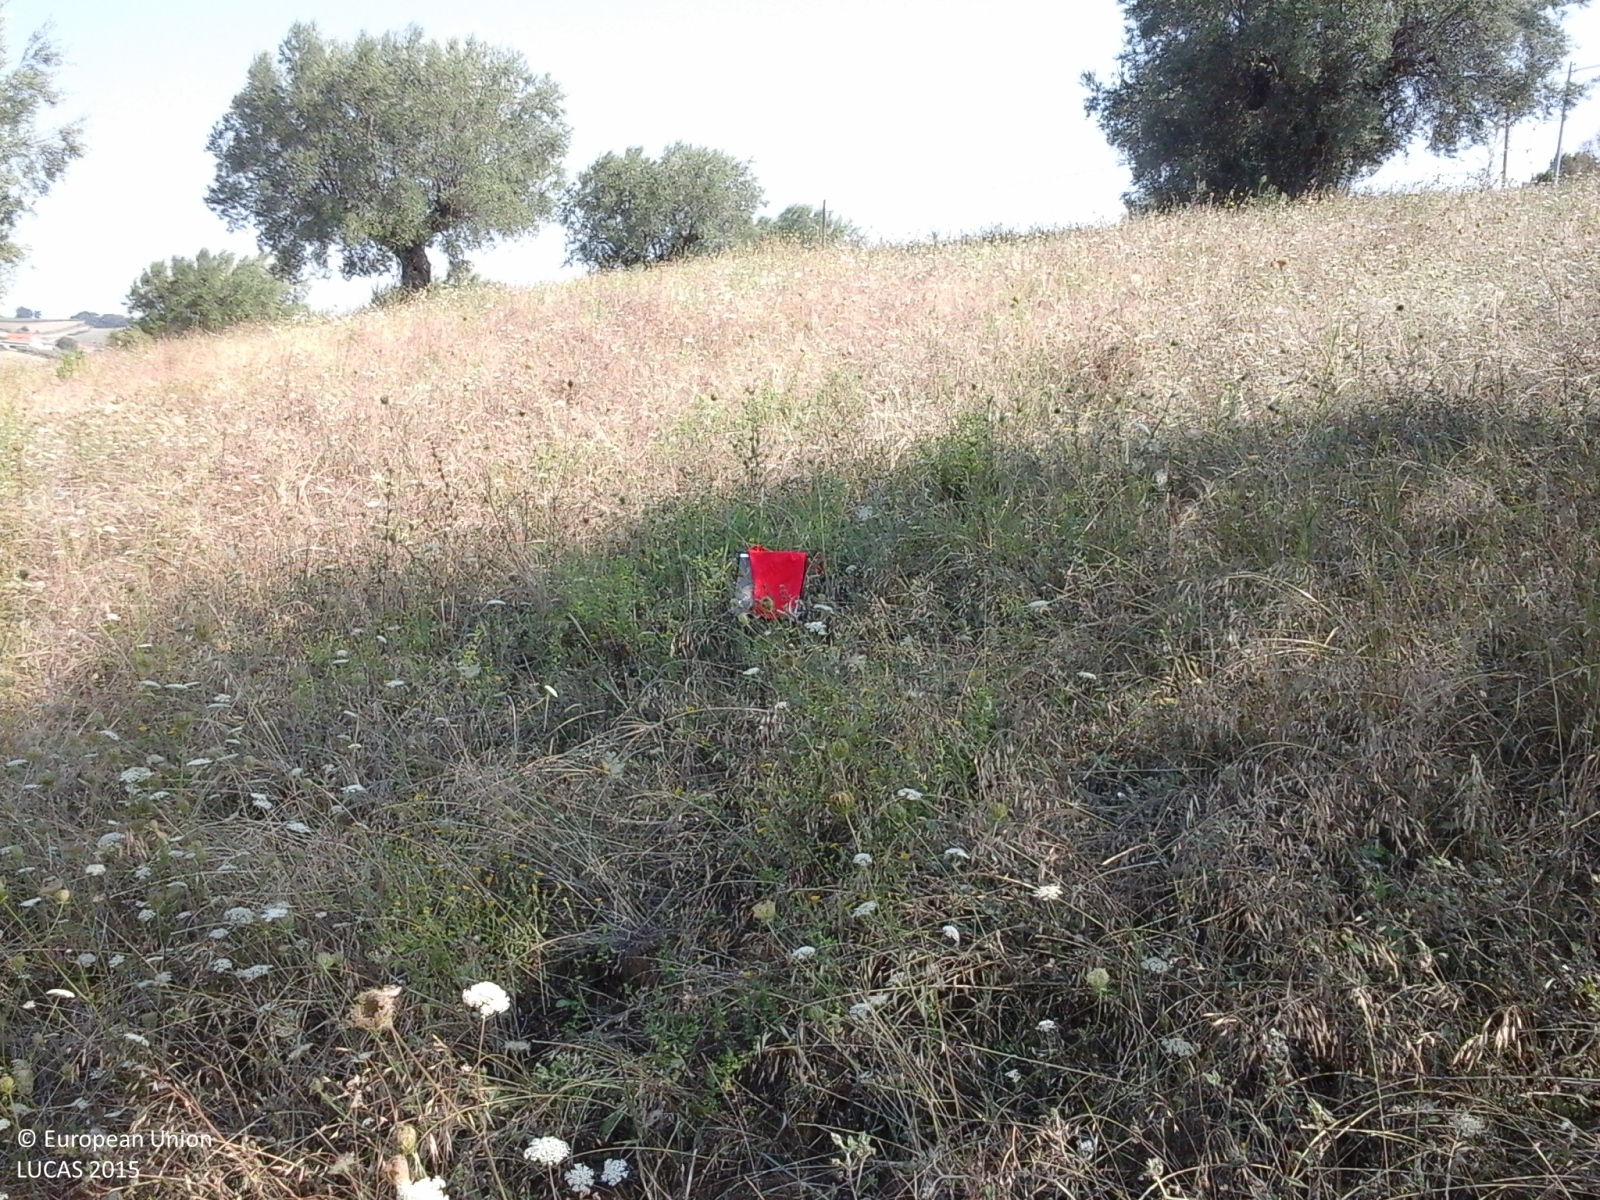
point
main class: Cropland
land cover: Nuts trees
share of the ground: < 10 %
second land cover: Spontaneously vegetated surfaces
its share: > 75 %
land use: Agriculture (excluding fallow land and kitchen gardens)
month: August
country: IT
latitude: 42.6710
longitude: 13.8568
